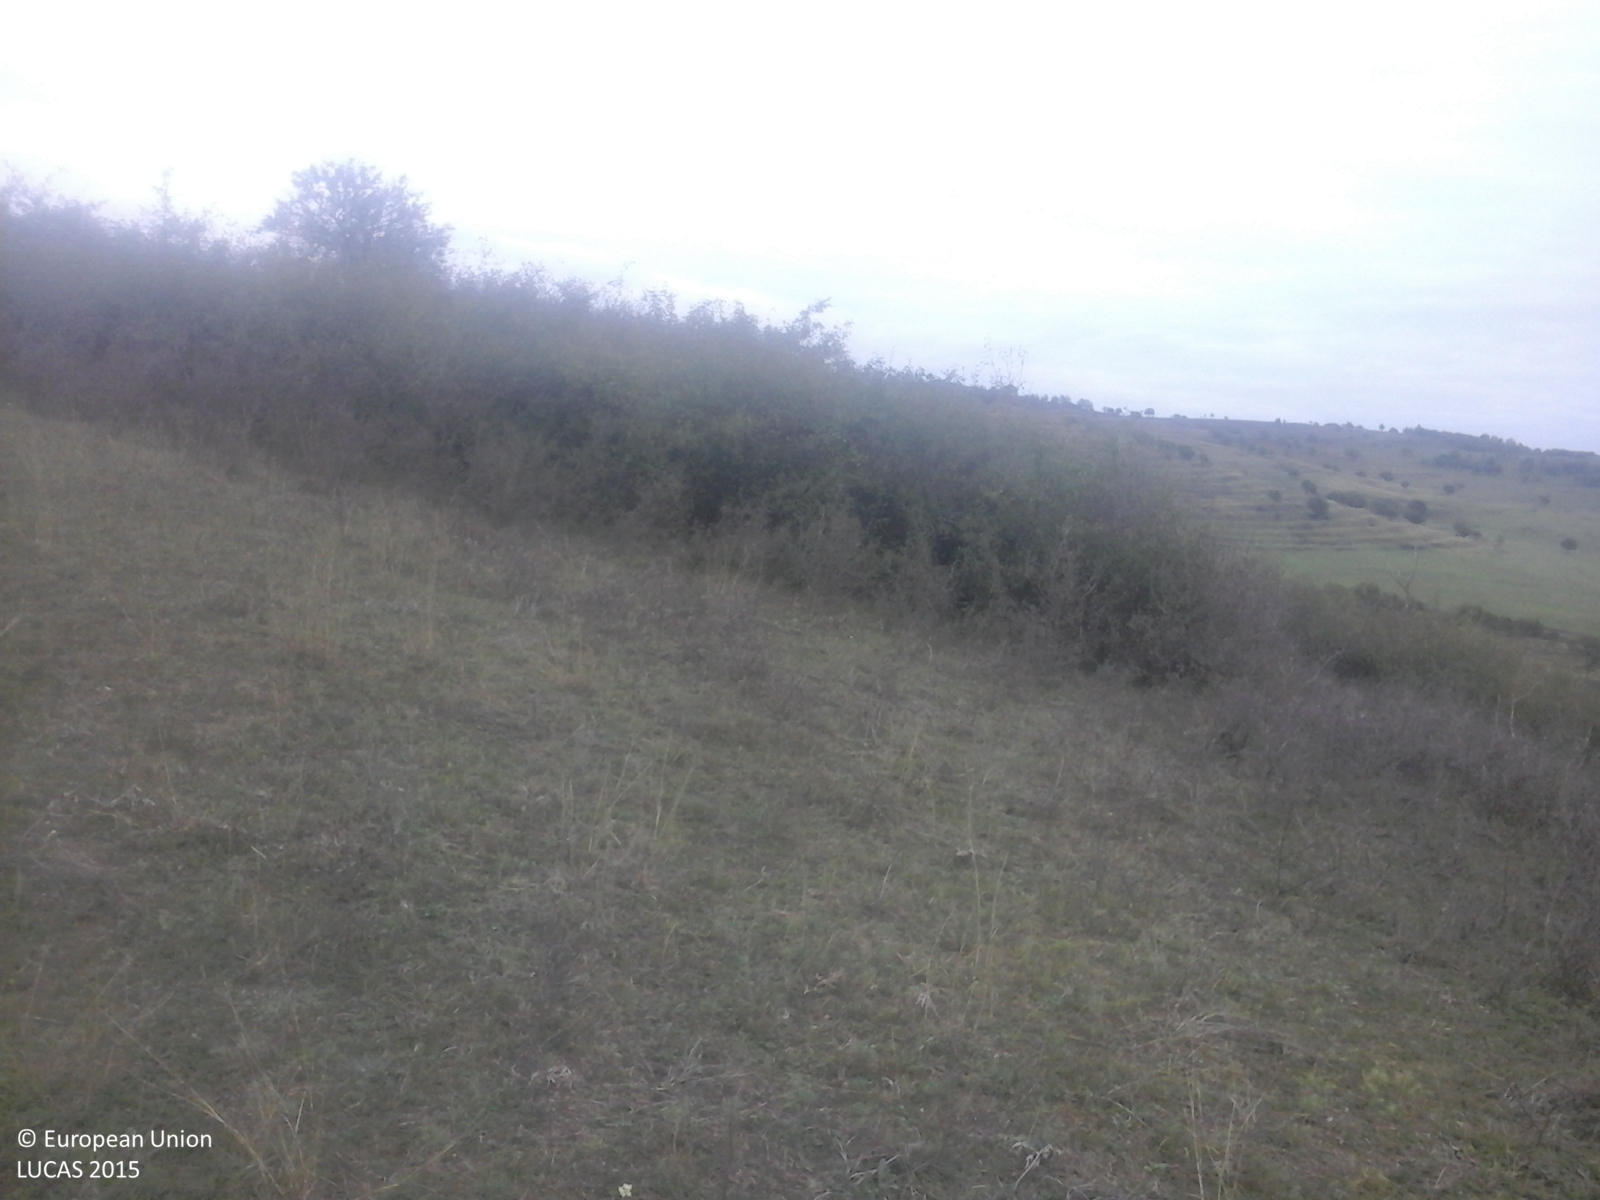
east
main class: Grassland
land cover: Grassland with sparse tree/shrub cover
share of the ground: > 75 %
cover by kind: herbaceous plants 85 %, shrubs 10 %, broadleaved forest trees 5 %
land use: Fallow land
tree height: < 5 m
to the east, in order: Grassland with sparse tree/shrub cover; Shrubland with sparse tree cover; Grassland with sparse tree/shrub cover; Shrubland without tree cover; Grassland with sparse tree/shrub cover
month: September
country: RO
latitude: 45.9083
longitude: 23.7982
